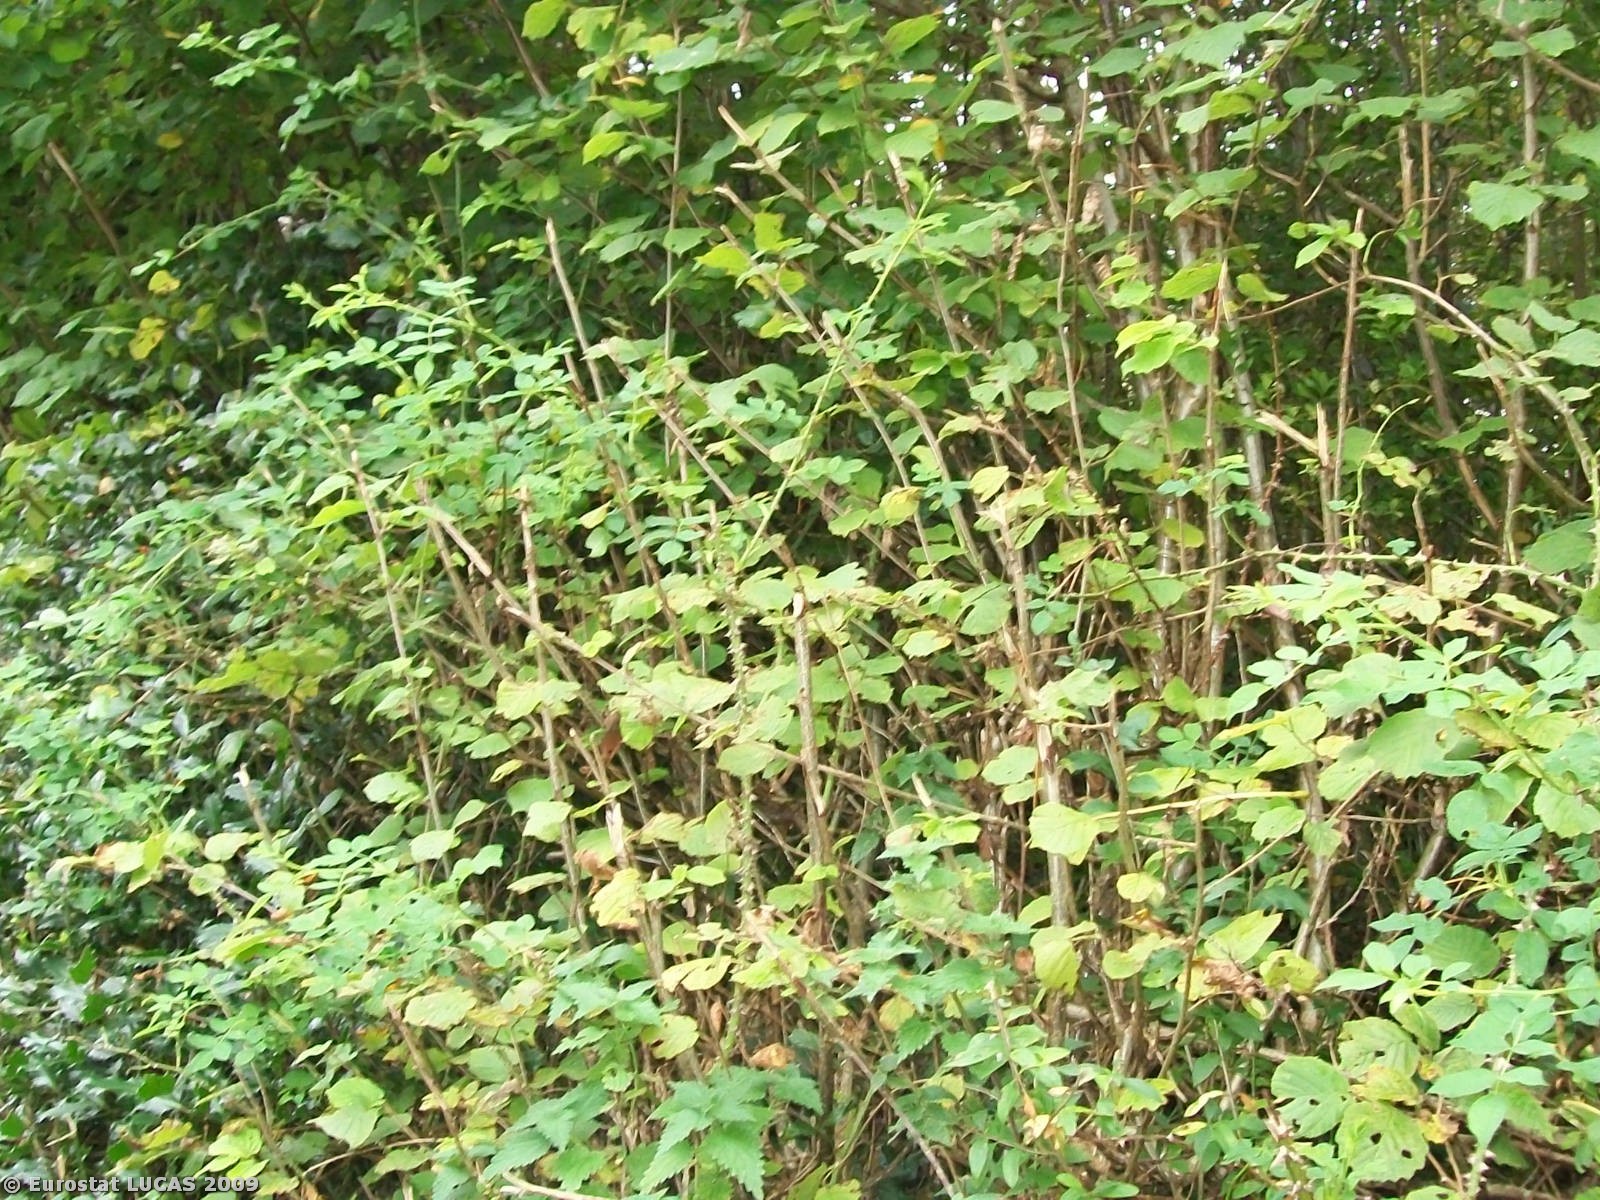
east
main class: Artificial land
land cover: Non built-up linear features
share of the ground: > 75 %
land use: Road transport
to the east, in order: Non built-up linear features; Broadleaved woodland; Dry stone walls; Grass margins; Paved roads, cycling and walking lanes; Grass margins; Fences; Grassland without tree/shrub cover; Fences; Grassland without tree/shrub cover; Fences; Lines of trees; Electric lines; Tracks; Grassland without tree/shrub cover
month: September
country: IE
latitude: 53.0235
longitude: -8.3005
